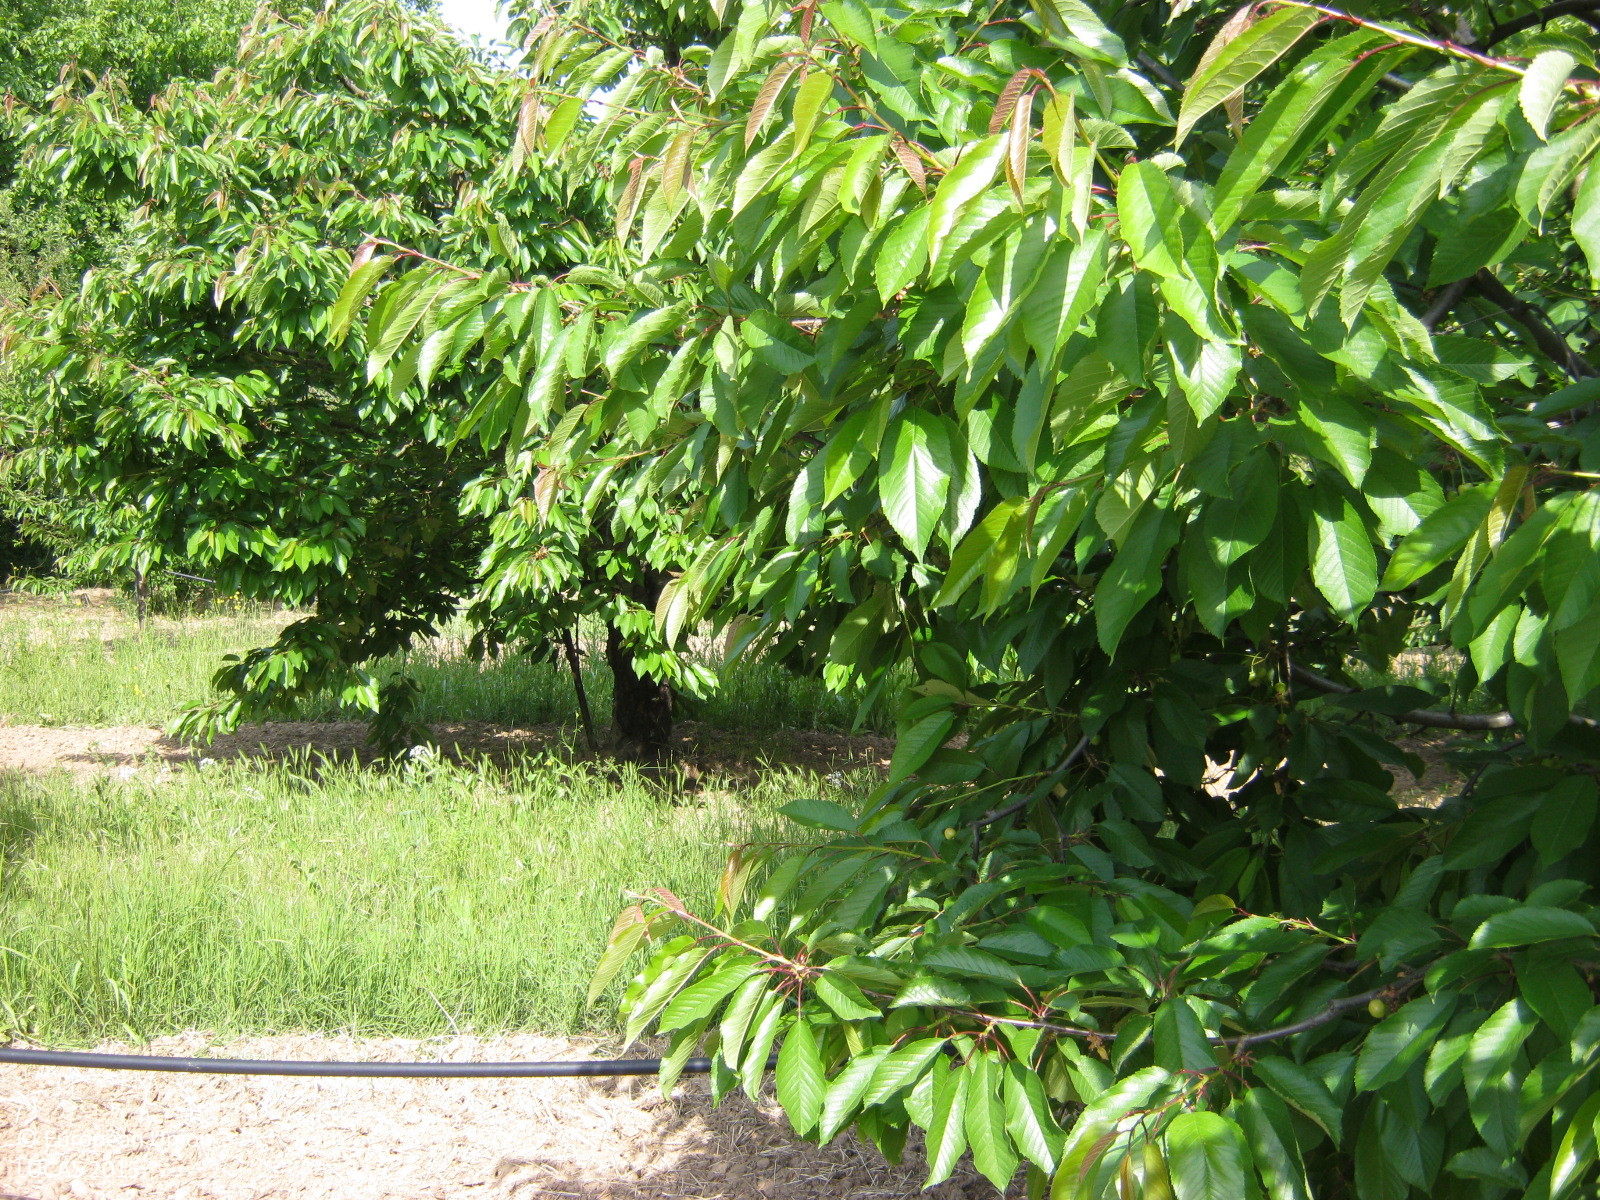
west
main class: Cropland
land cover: Cherry fruit
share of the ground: 25 - 50 %
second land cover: Other bare soil
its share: > 75 %
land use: Agriculture (excluding fallow land and kitchen gardens)
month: June
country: GR
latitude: 37.4868
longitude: 22.5047
